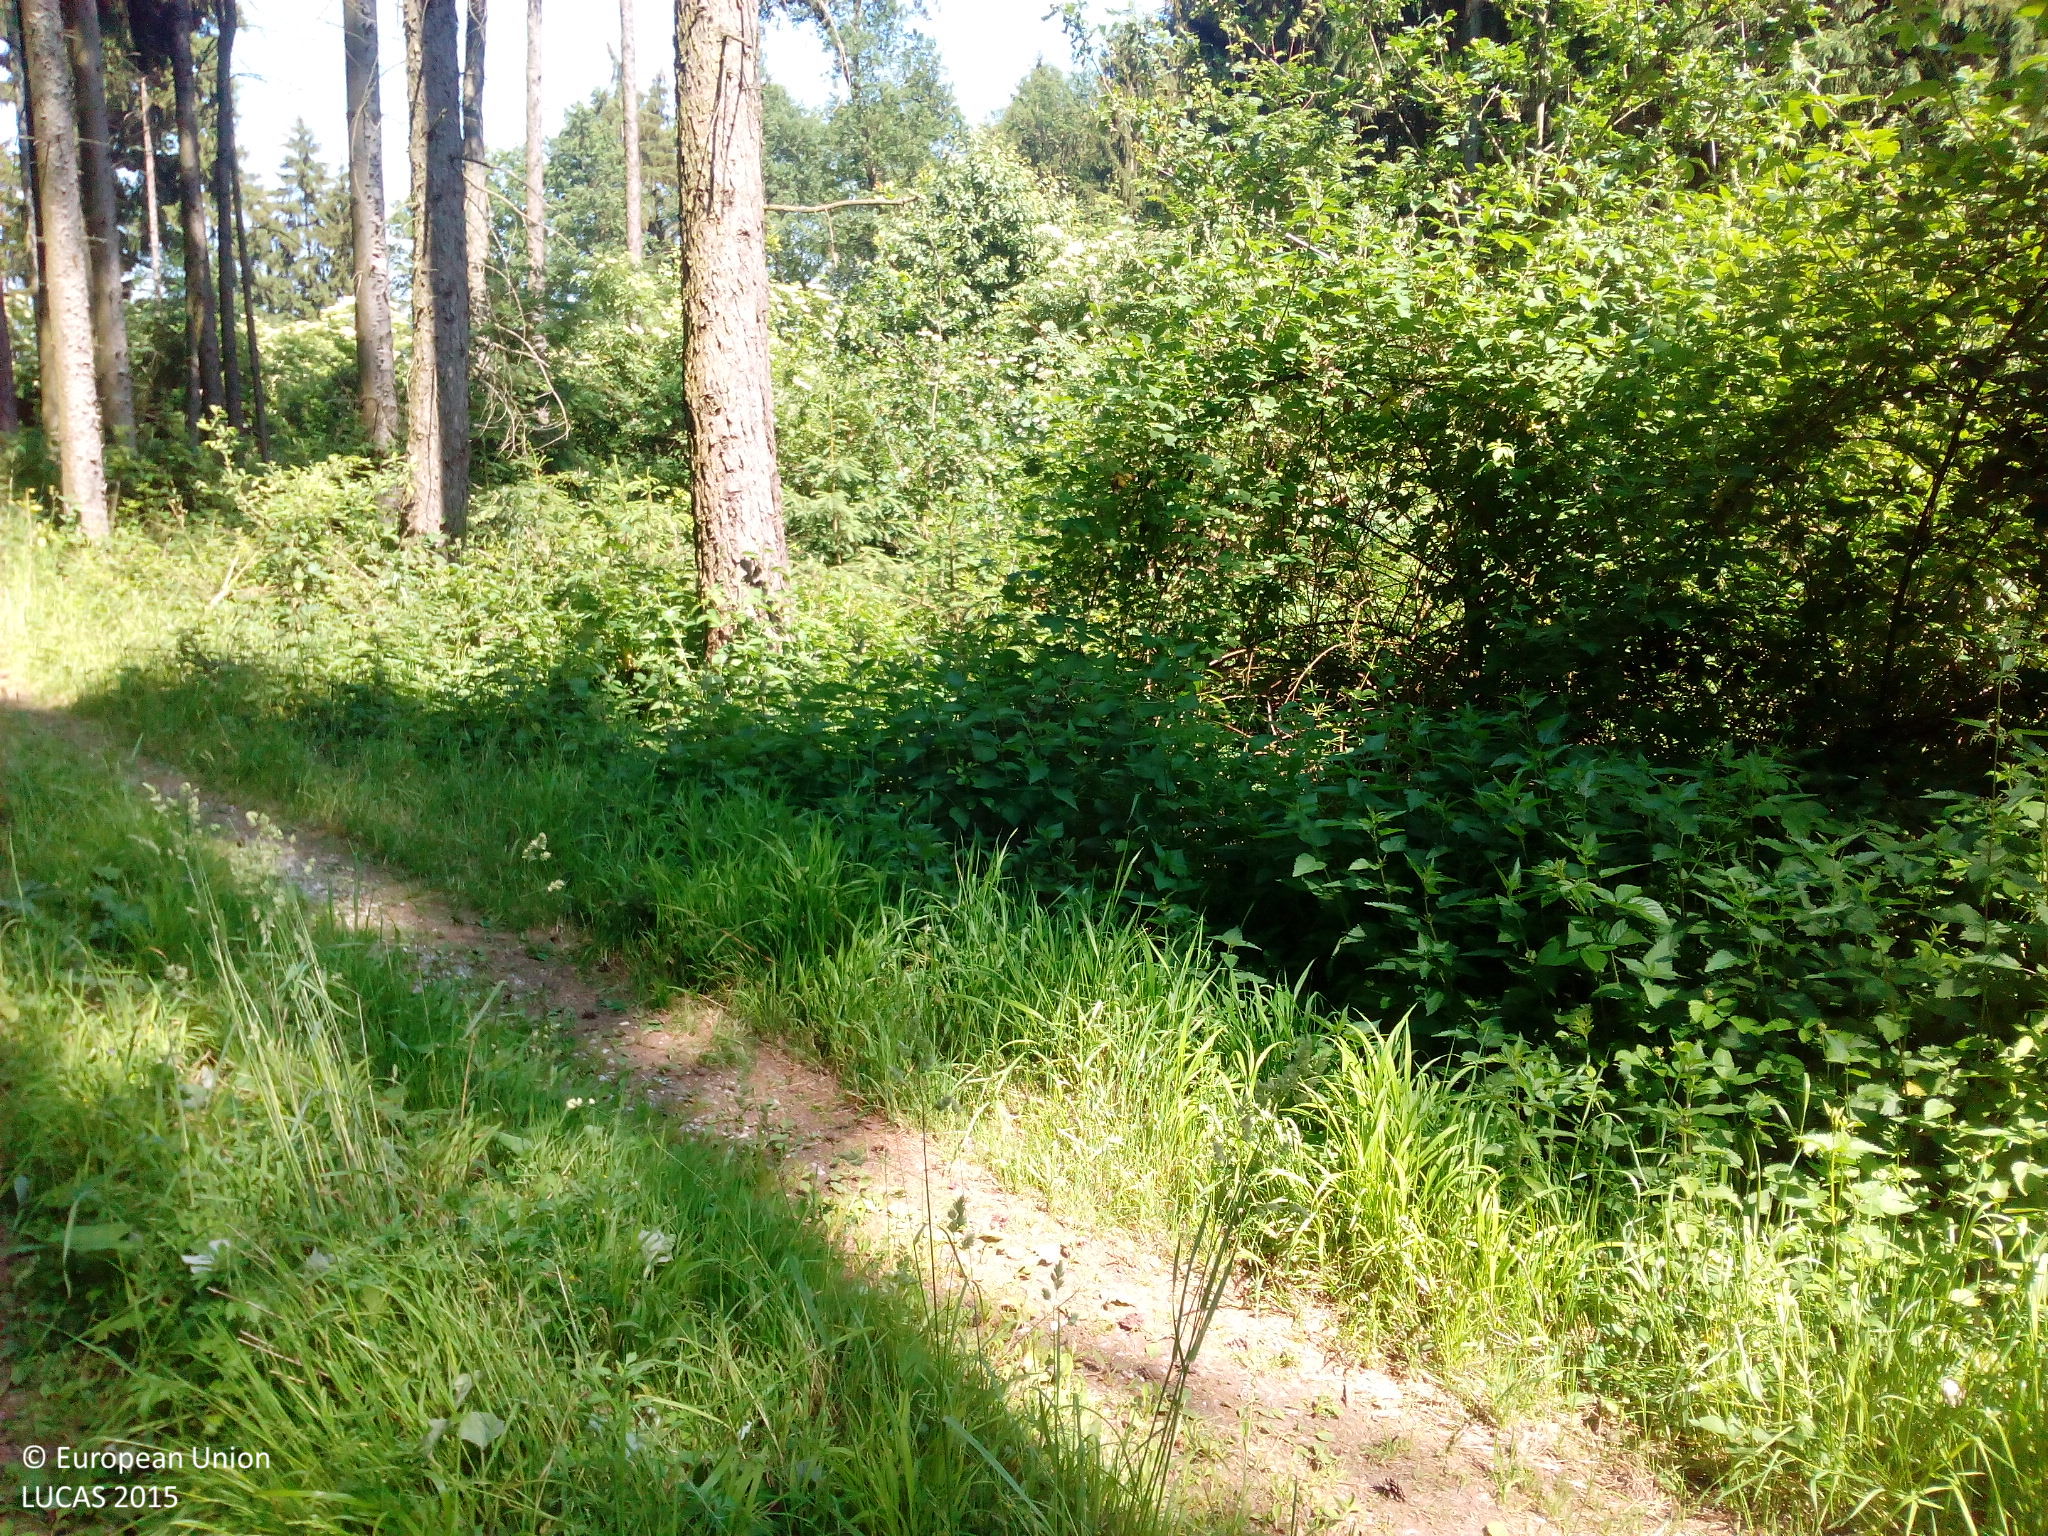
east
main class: Woodland
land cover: Spruce dominated mixed woodland
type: hemiboreal forest and nemoral coniferous forest and mixed broadleaved-coniferous forest
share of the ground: 50 - 75 %
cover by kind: coniferous forest trees 35 %, herbaceous plants 35 %, broadleaved forest trees 20 %, shrubs 10 %
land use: Forestry
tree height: > 5 m
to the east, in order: Grass margins; Tracks; Other coniferous woodland; Broadleaved woodland; Shrubland with sparse tree cover; Broadleaved woodland; Grass margins; Tracks; Temporary grasslands; Rape and turnip rape
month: June
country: DE
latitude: 48.7913
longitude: 12.4086
